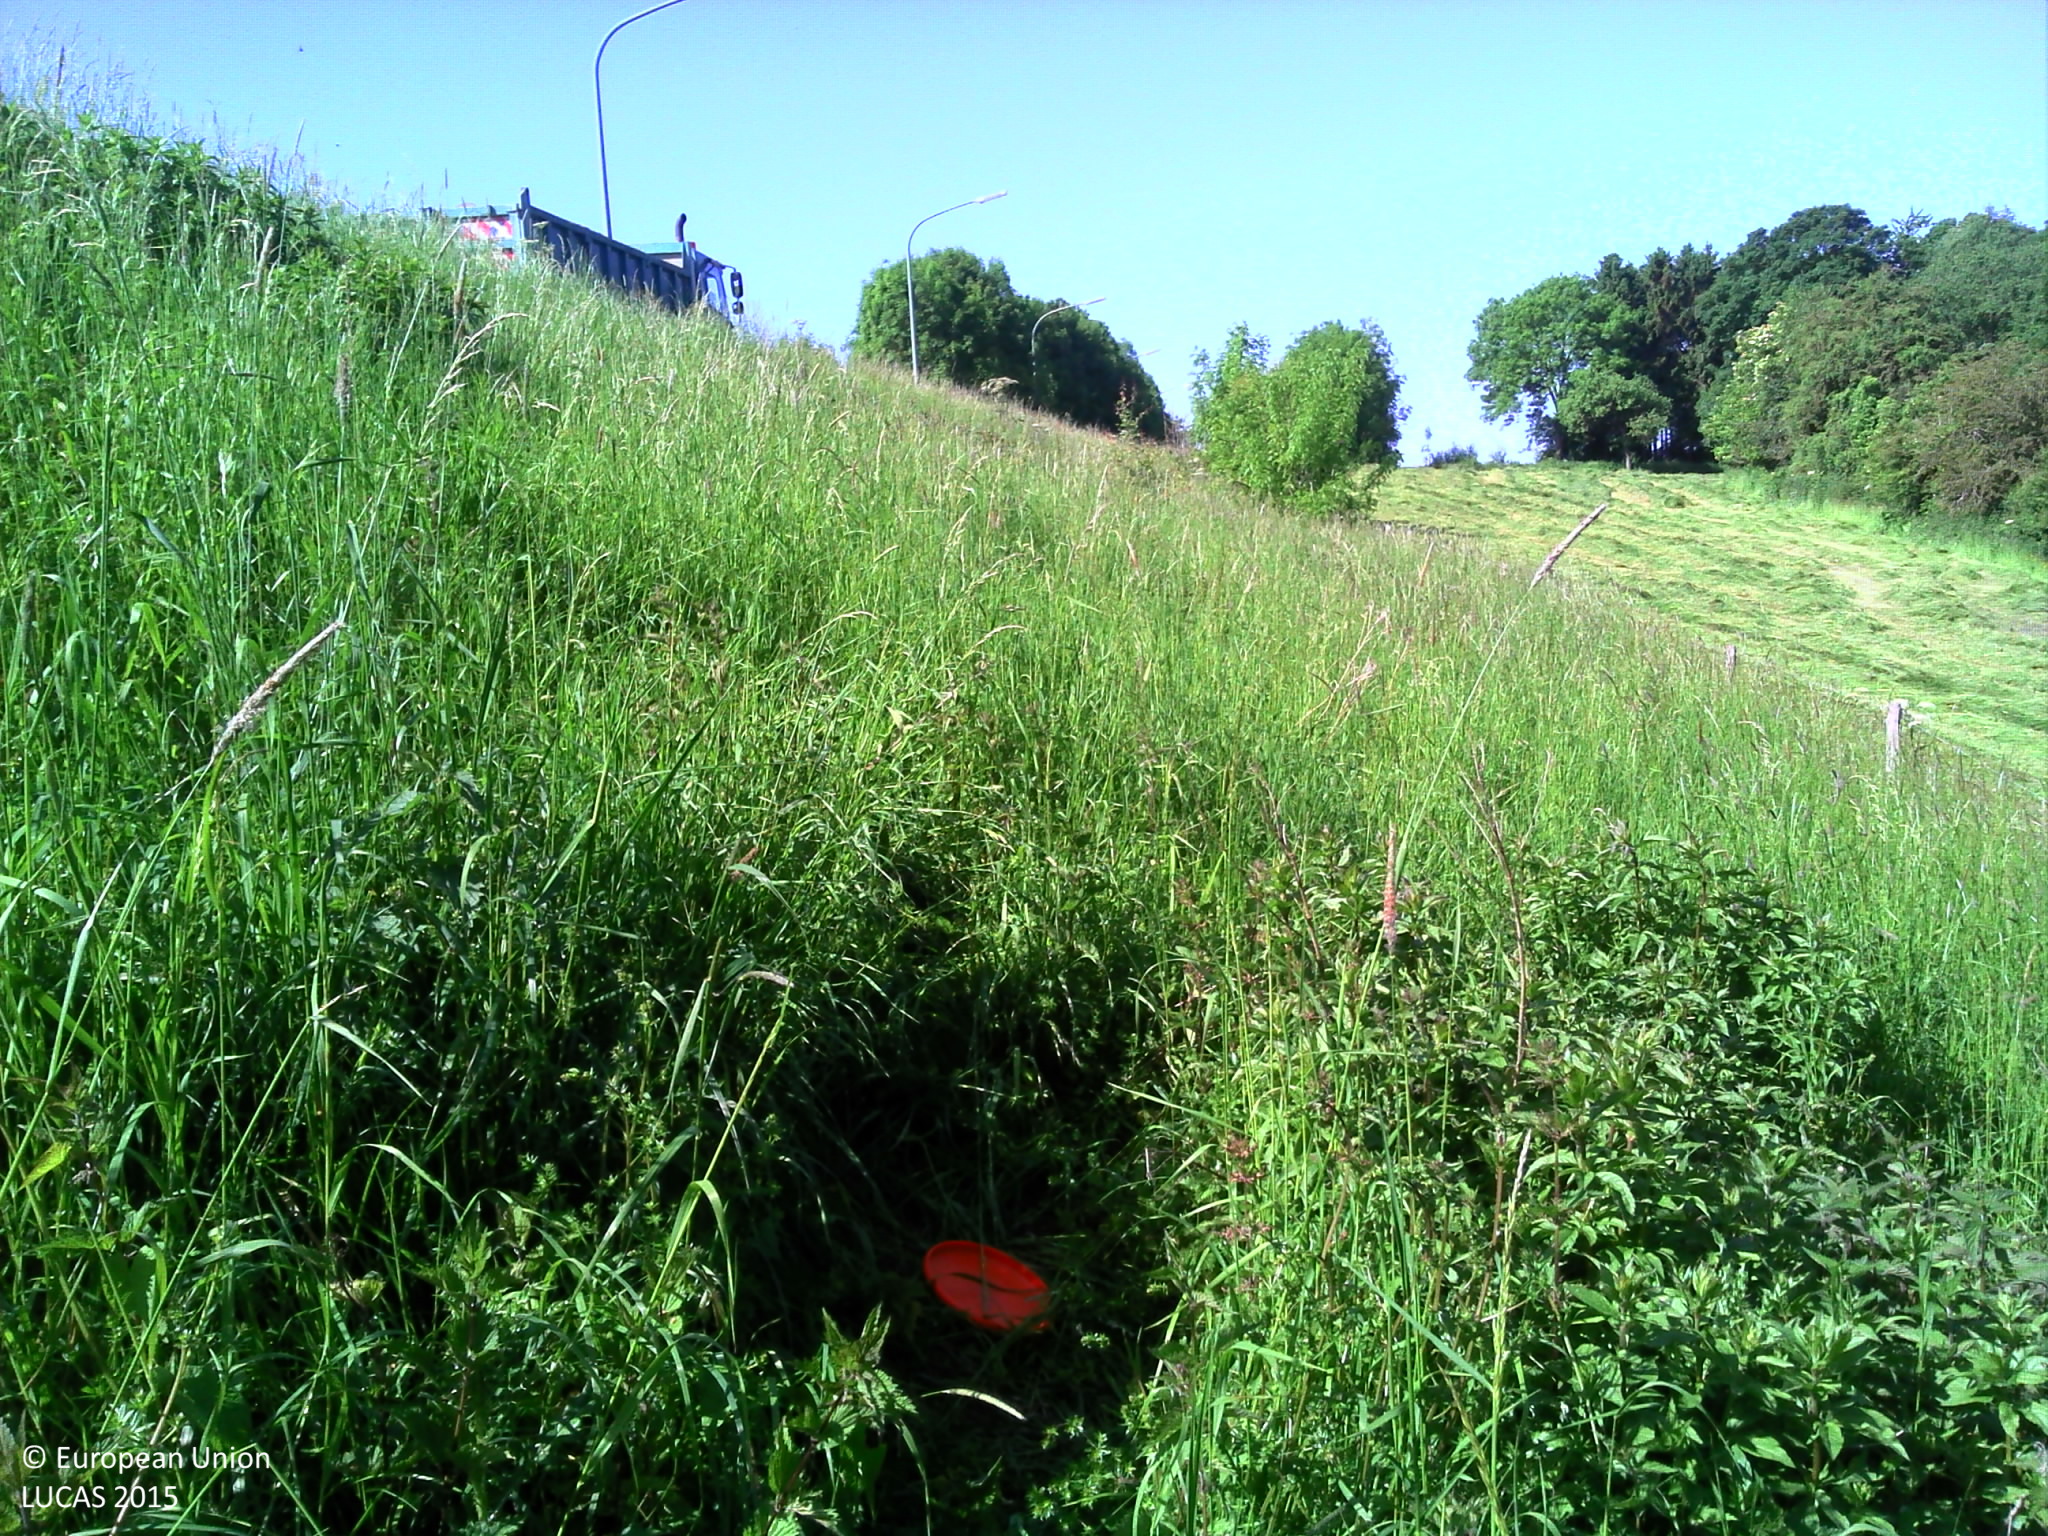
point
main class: Grassland
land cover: Spontaneously vegetated surfaces
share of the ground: > 75 %
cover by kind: herbaceous plants 100 %
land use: Semi-natural and natural areas not in use
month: June
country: BE
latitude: 50.5172
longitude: 5.6970
